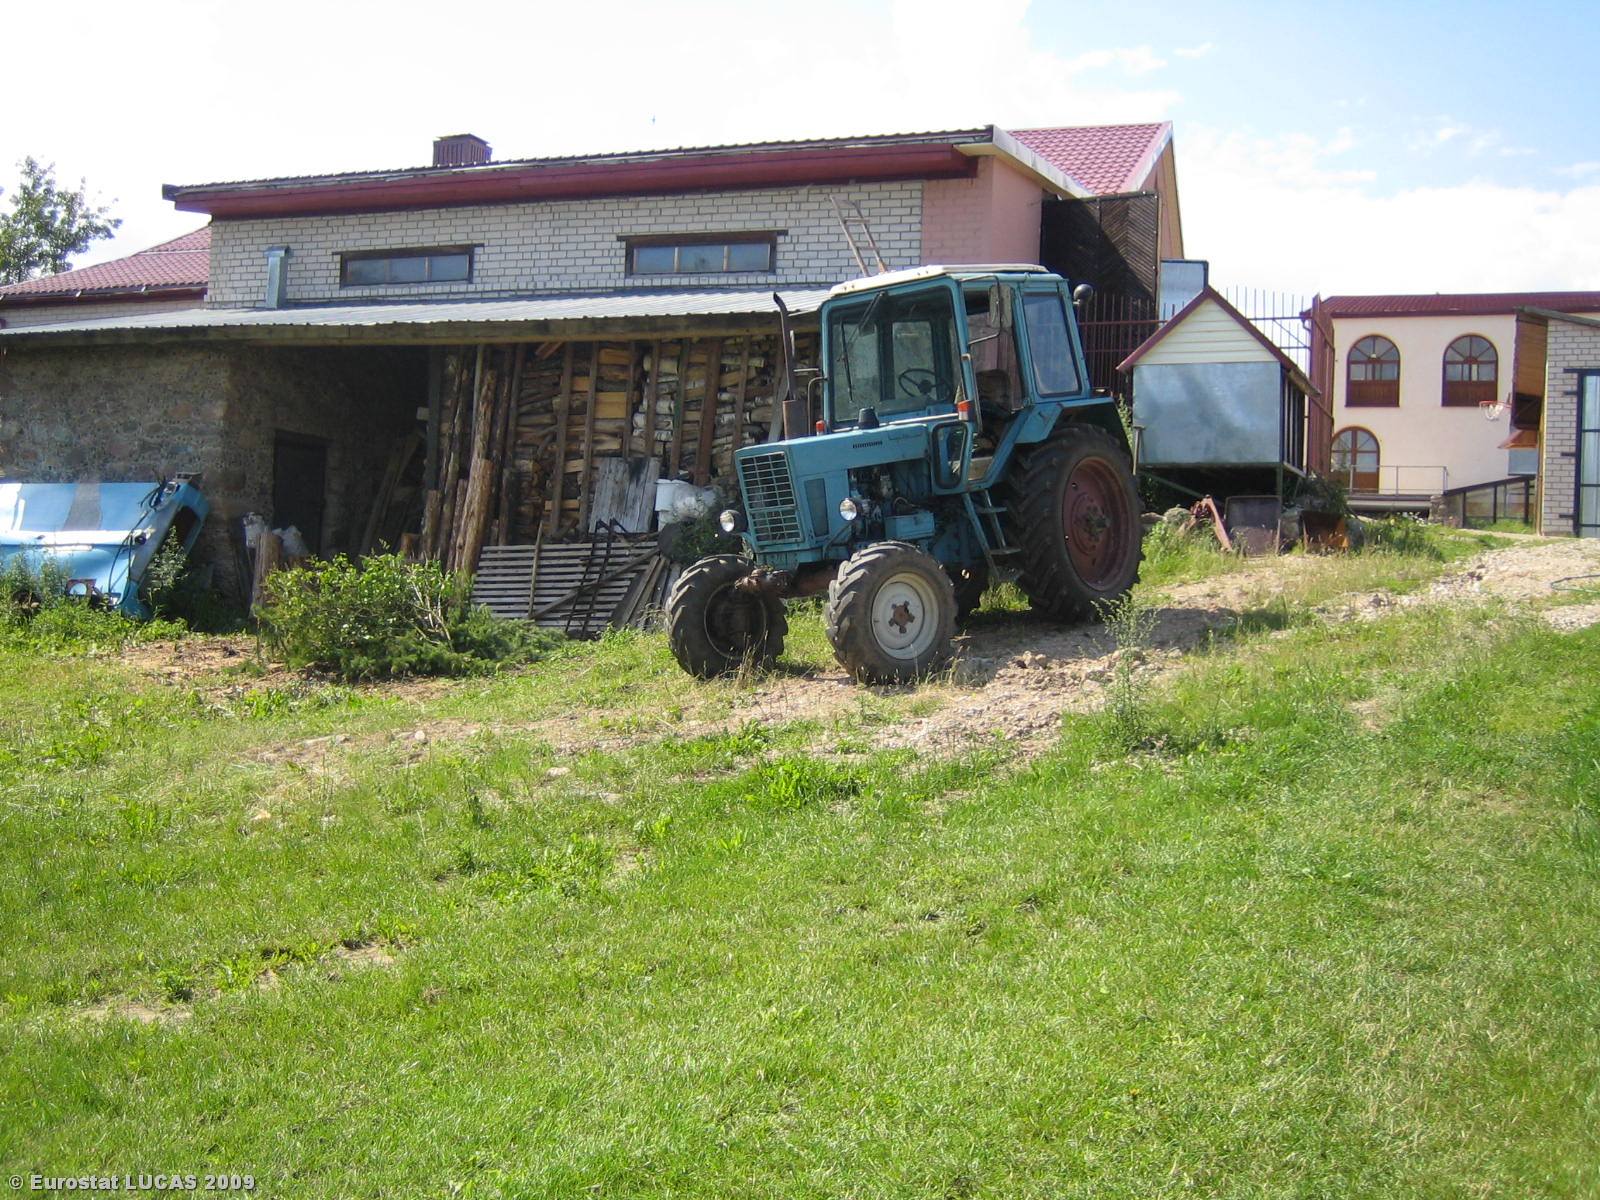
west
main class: Grassland
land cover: Grassland without tree/shrub cover
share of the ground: > 75 %
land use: Agriculture (excluding fallow land and kitchen gardens)
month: July
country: LT
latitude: 55.7475
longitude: 25.8240
